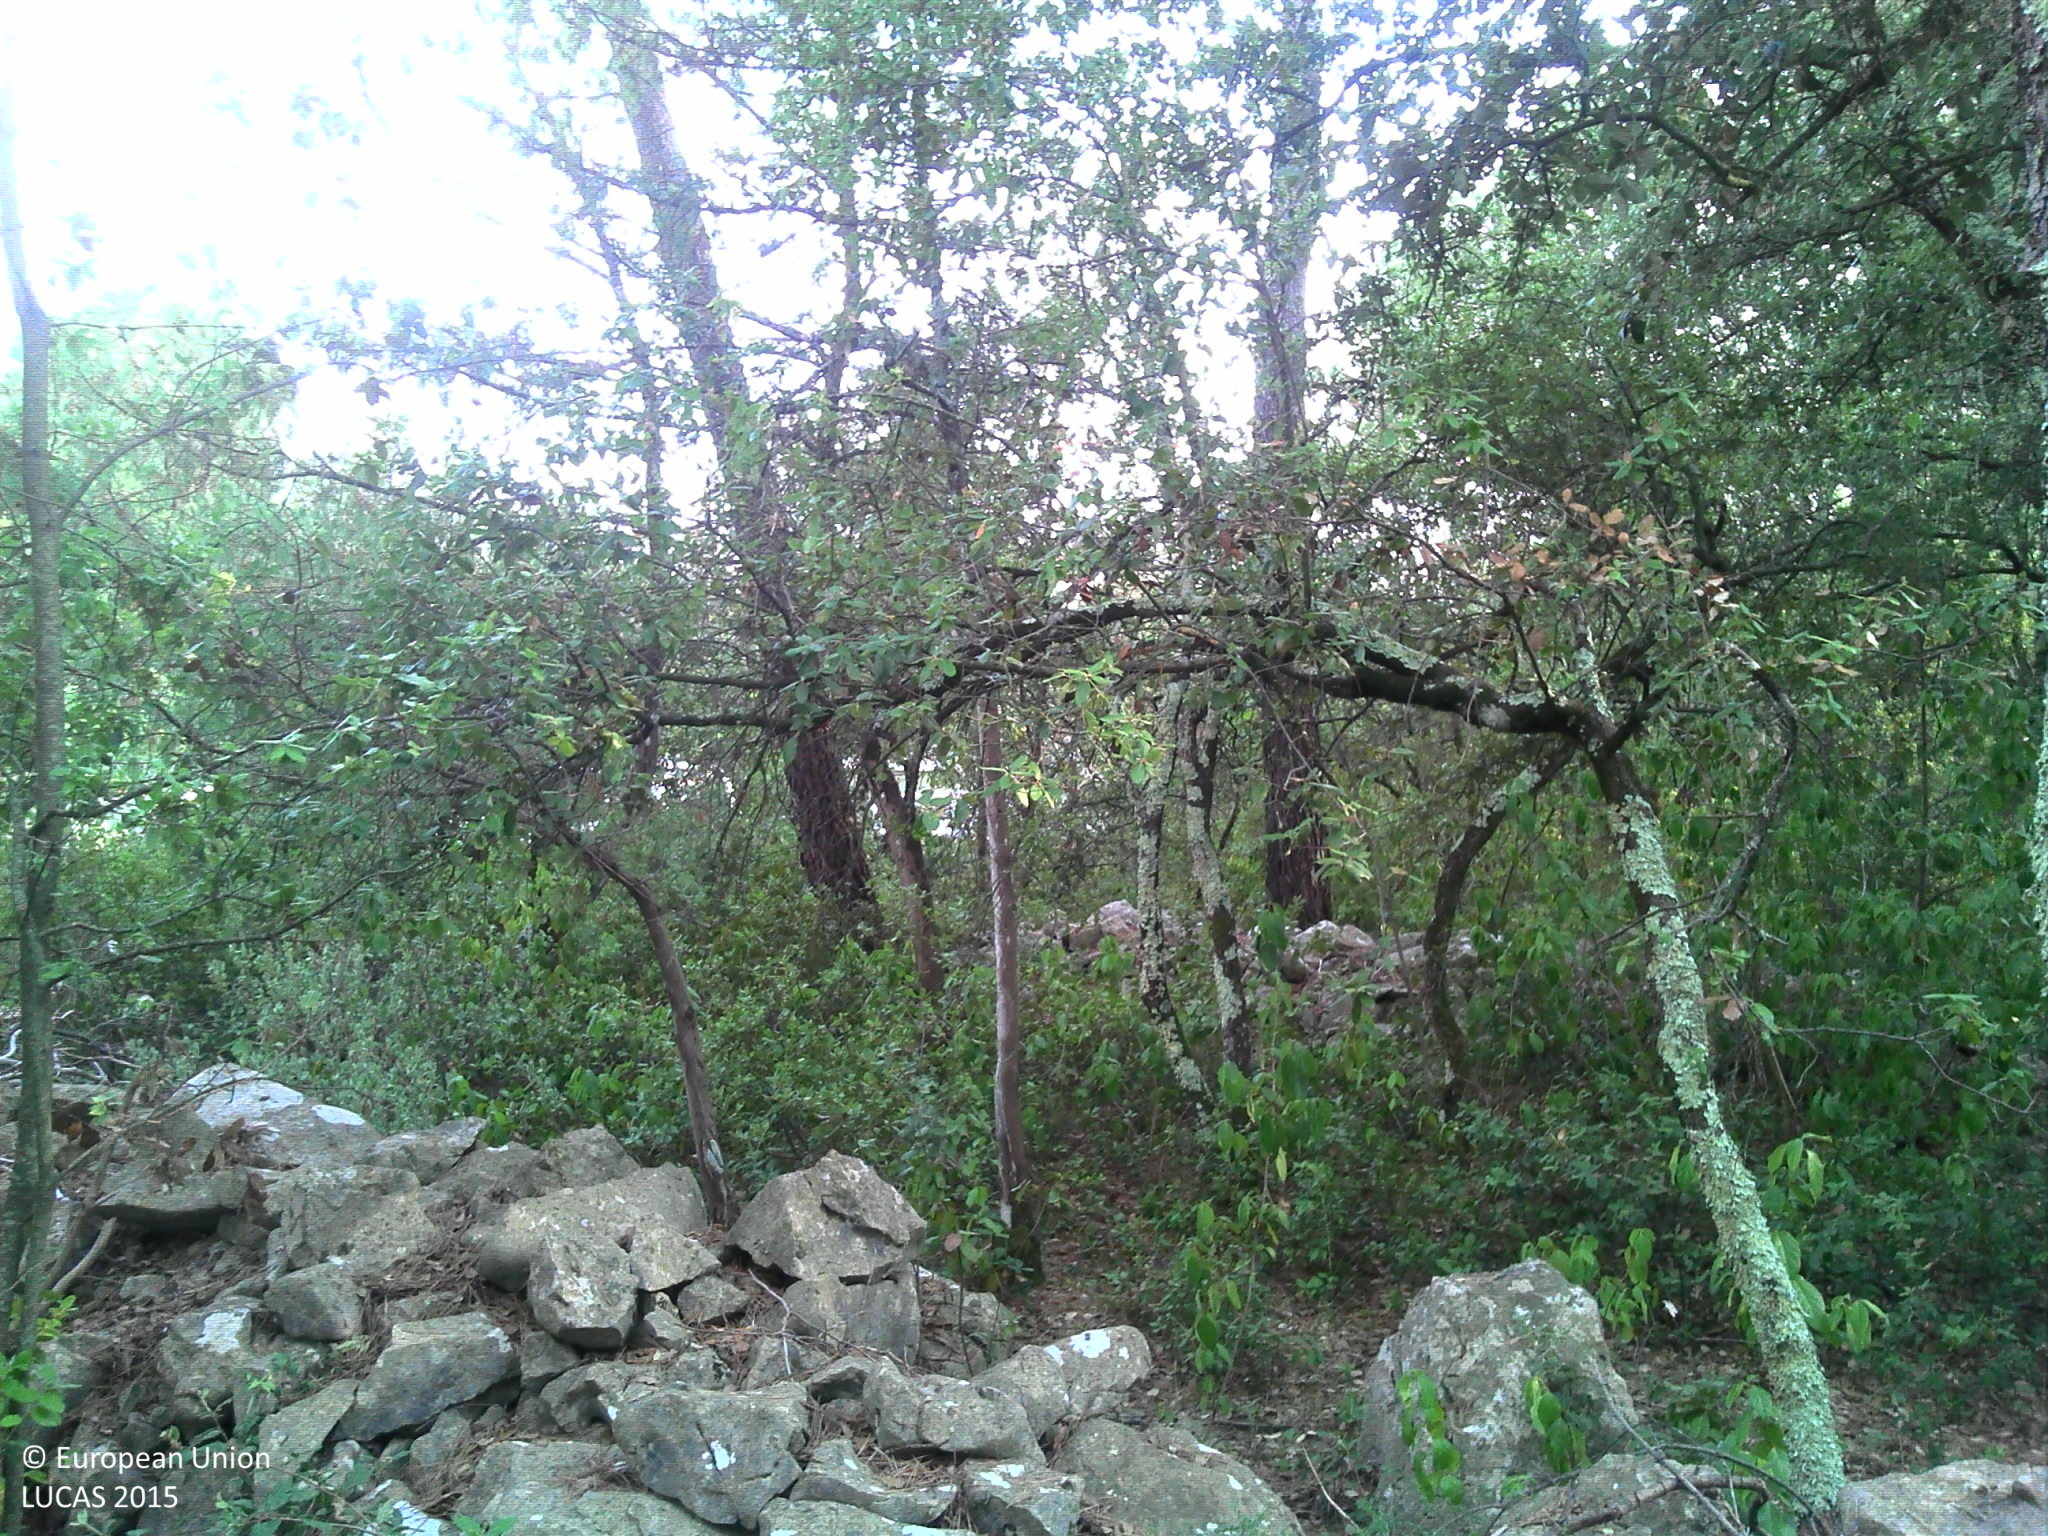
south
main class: Woodland
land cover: Pine dominated mixed woodland
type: coniferous forest of the mediterranean region
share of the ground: > 75 %
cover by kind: broadleaved forest trees 50 %, coniferous forest trees 25 %, shrubs 15 %, unconsolidated bare surface 10 %
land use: Semi-natural and natural areas not in use
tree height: > 5 m
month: August
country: FR
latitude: 43.5093
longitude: 6.3350
